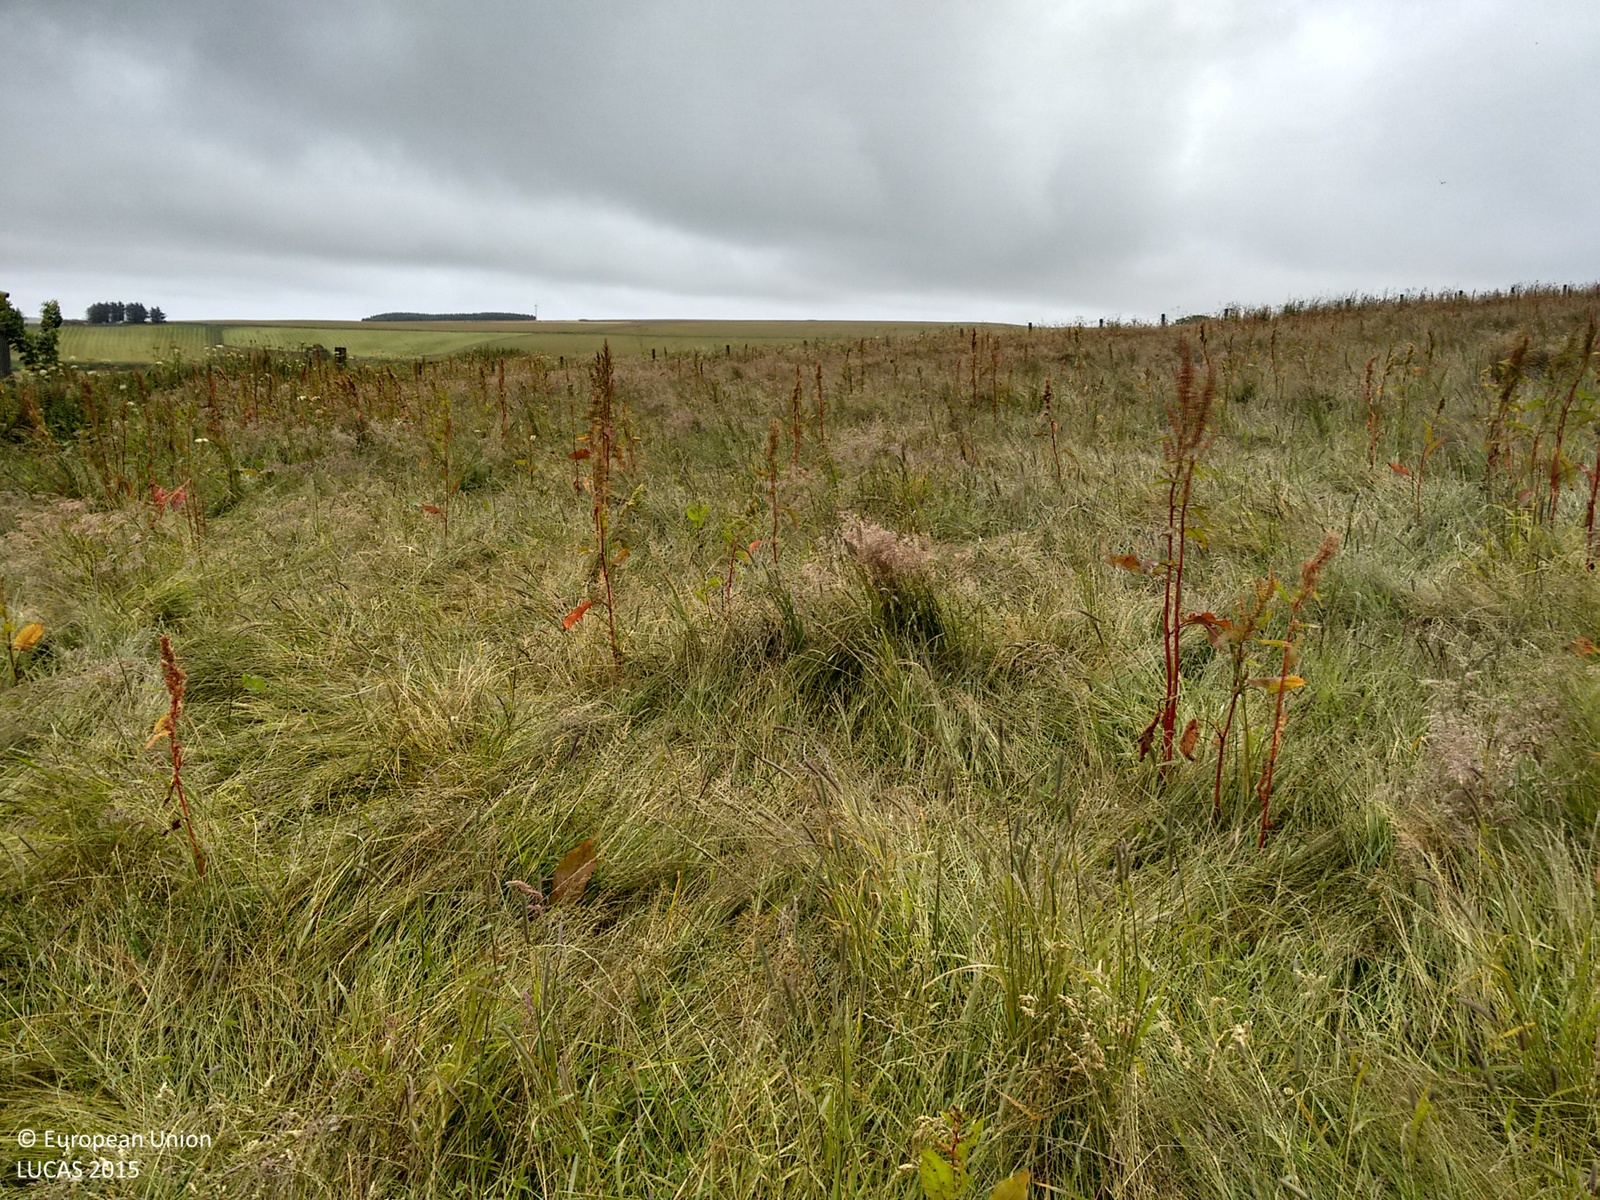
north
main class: Grassland
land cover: Grassland without tree/shrub cover
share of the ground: > 75 %
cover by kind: herbaceous plants 100 %
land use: Agriculture (excluding fallow land and kitchen gardens)
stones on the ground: 25 - 50 %
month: July
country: GB
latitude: 57.6313
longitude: -2.3252
